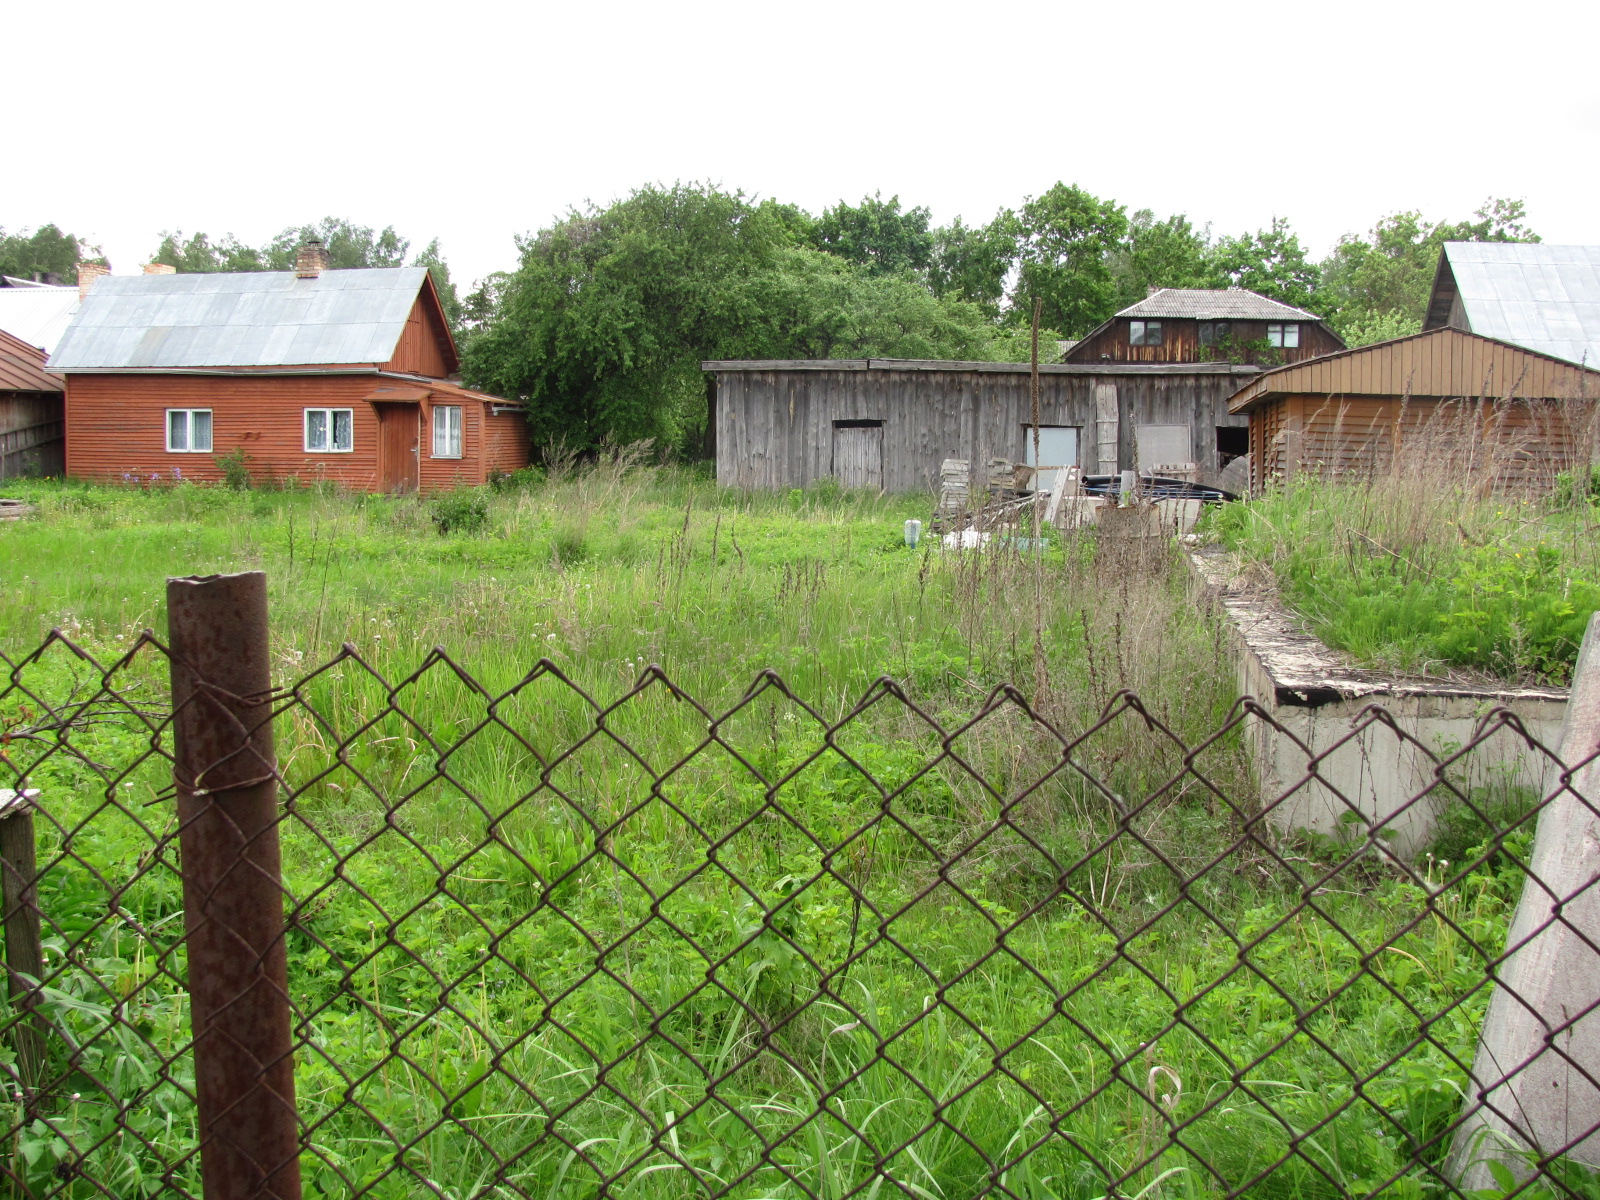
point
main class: Grassland
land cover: Grassland without tree/shrub cover
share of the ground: > 75 %
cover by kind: herbaceous plants 100 %
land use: Residential
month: June
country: LV
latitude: 56.8060
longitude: 23.9880
